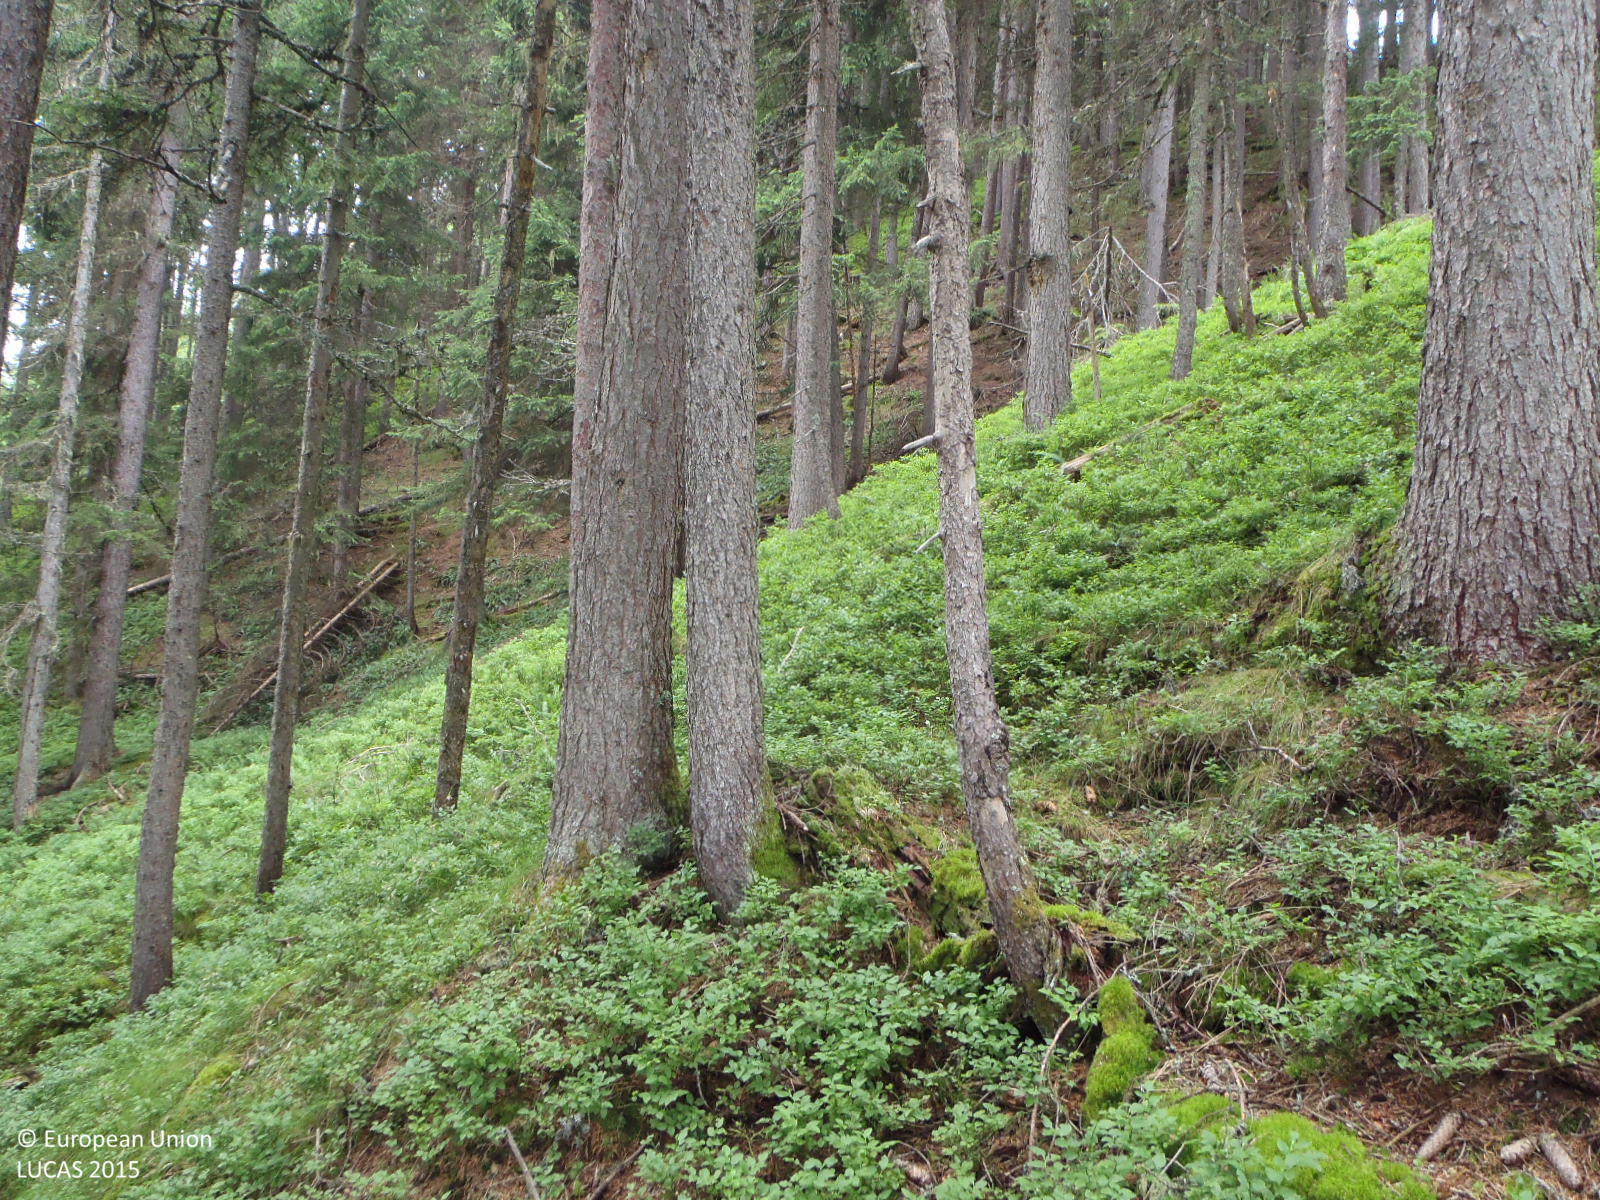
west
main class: Woodland
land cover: Spruce dominated coniferous woodland
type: alpine coniferous forest
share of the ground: > 75 %
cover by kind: coniferous forest trees 90 %, shrubs 10 %
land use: Forestry
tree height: > 5 m
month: July
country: AT
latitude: 47.3445
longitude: 11.8119
